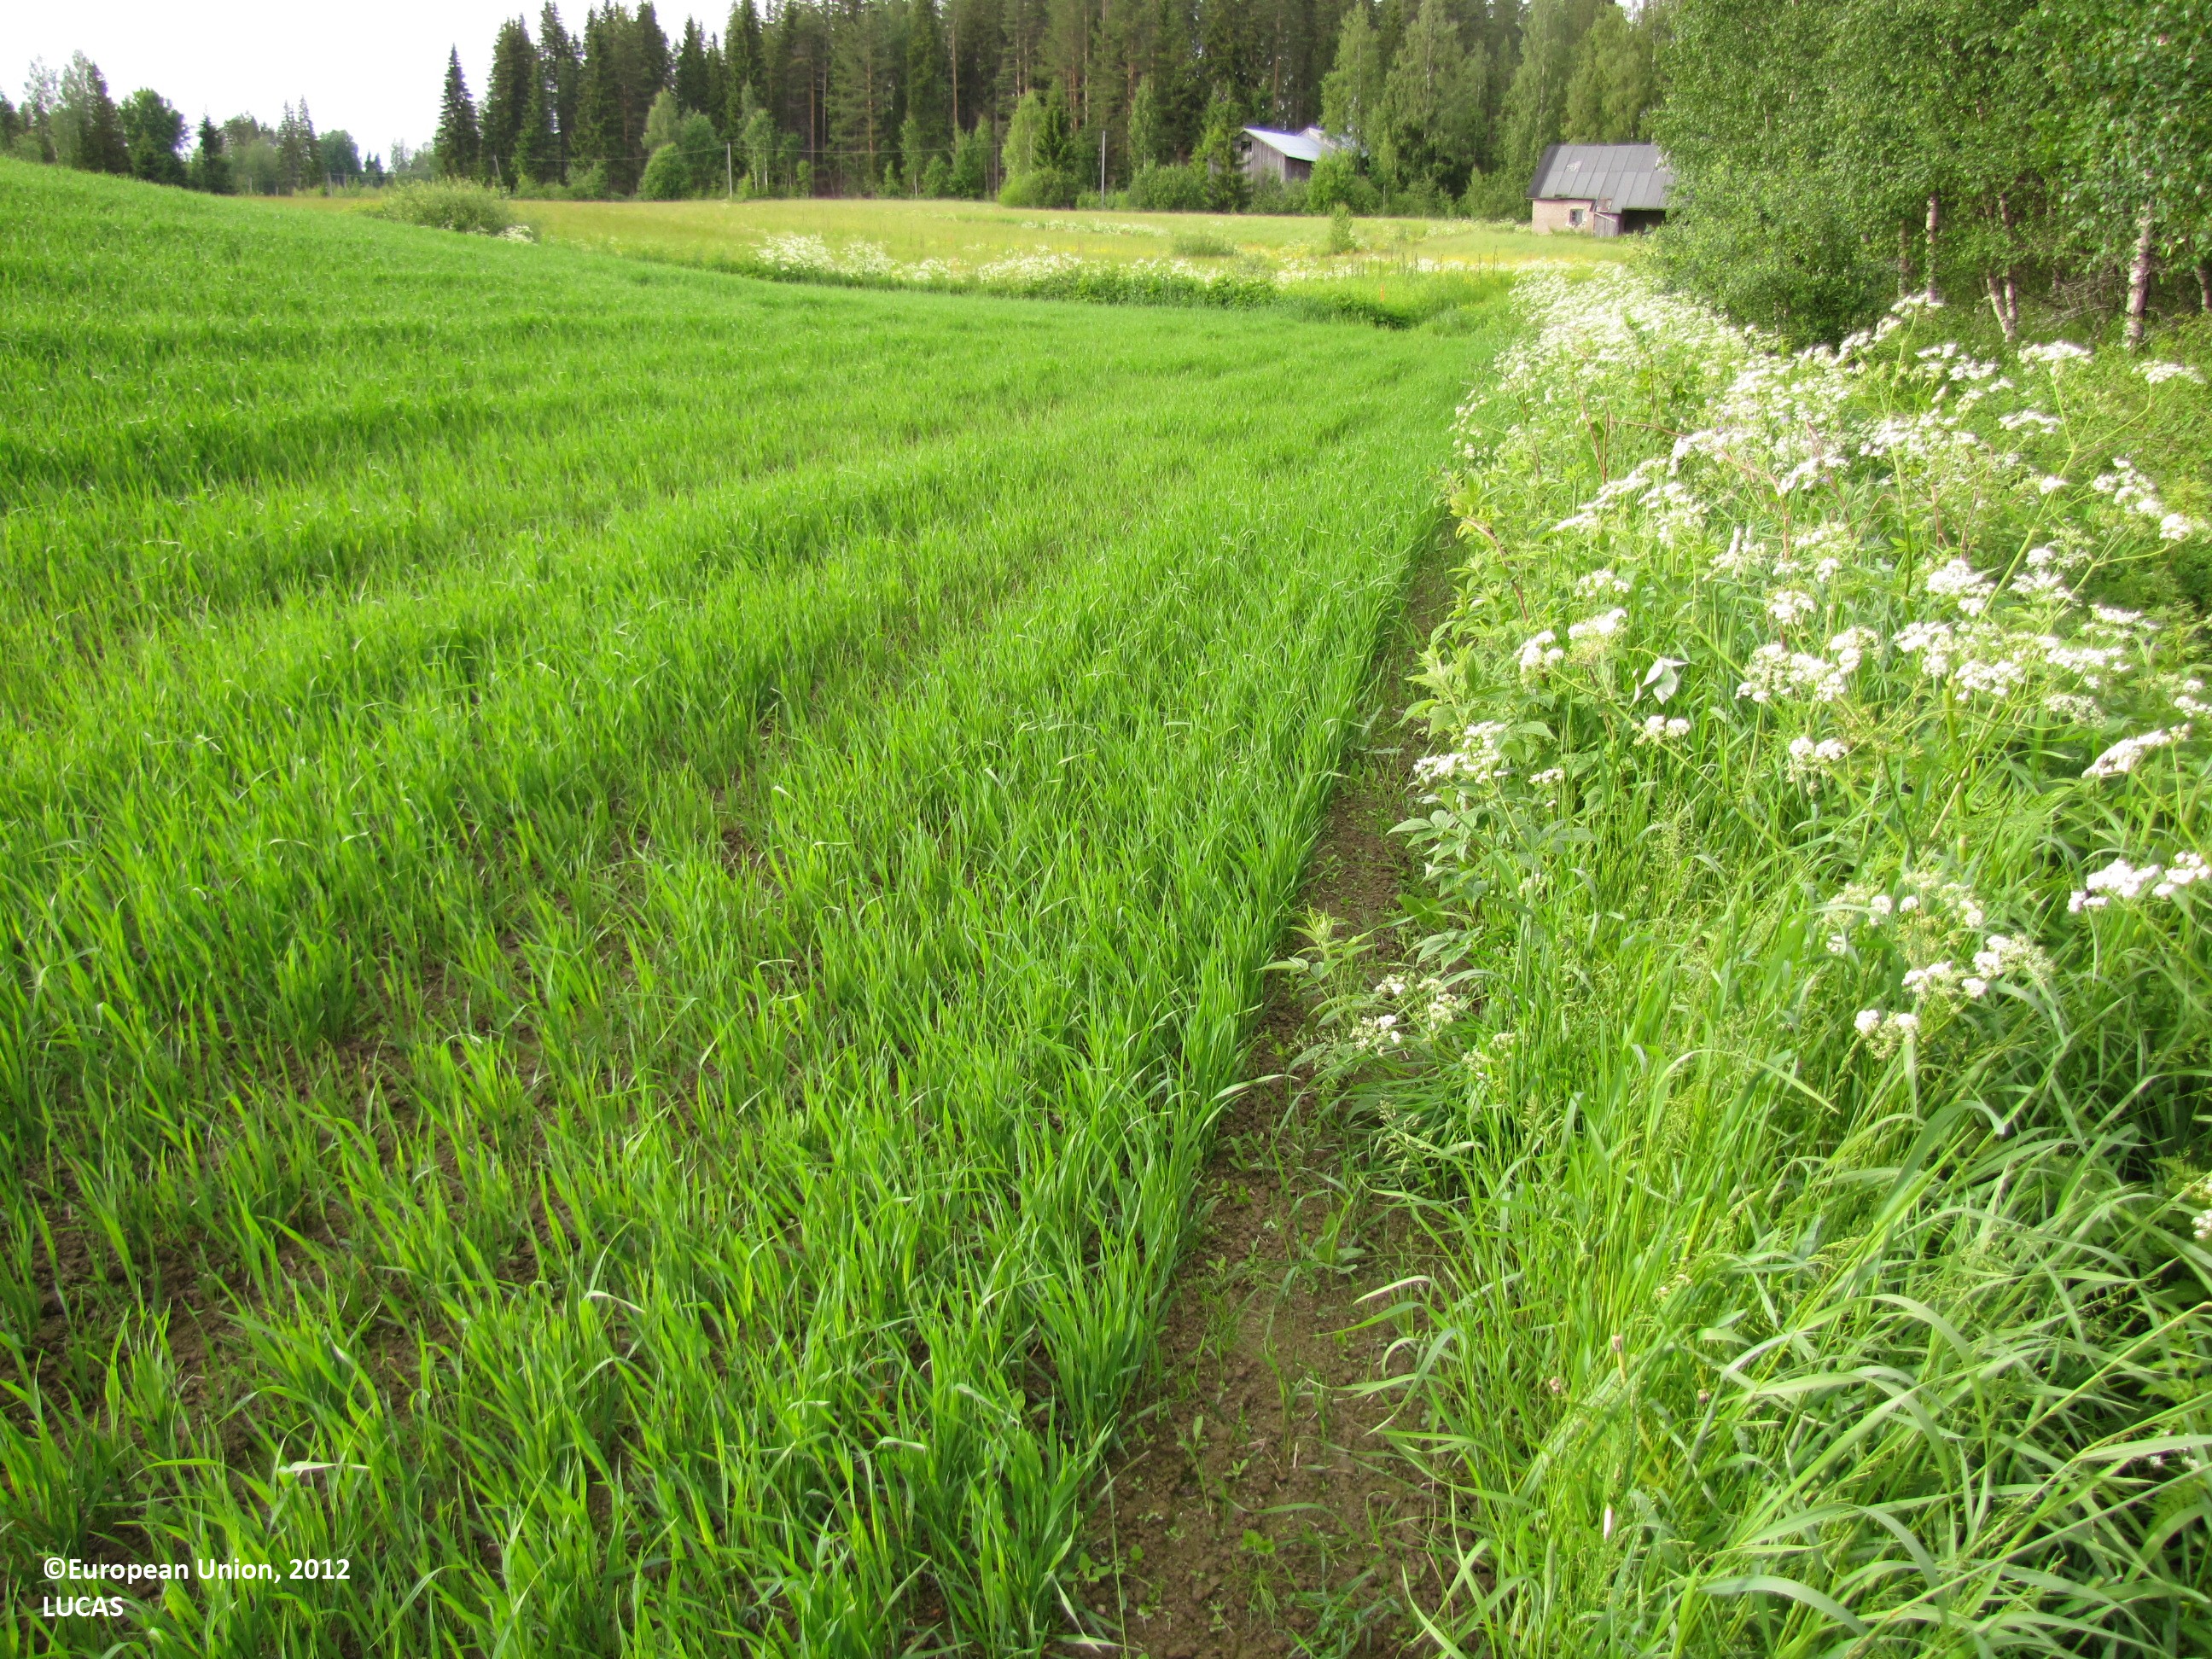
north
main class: Cropland
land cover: Oats
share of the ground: 50 - 75 %
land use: Agriculture (excluding fallow land and kitchen gardens)
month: June
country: FI
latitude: 61.7993
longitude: 24.4547
